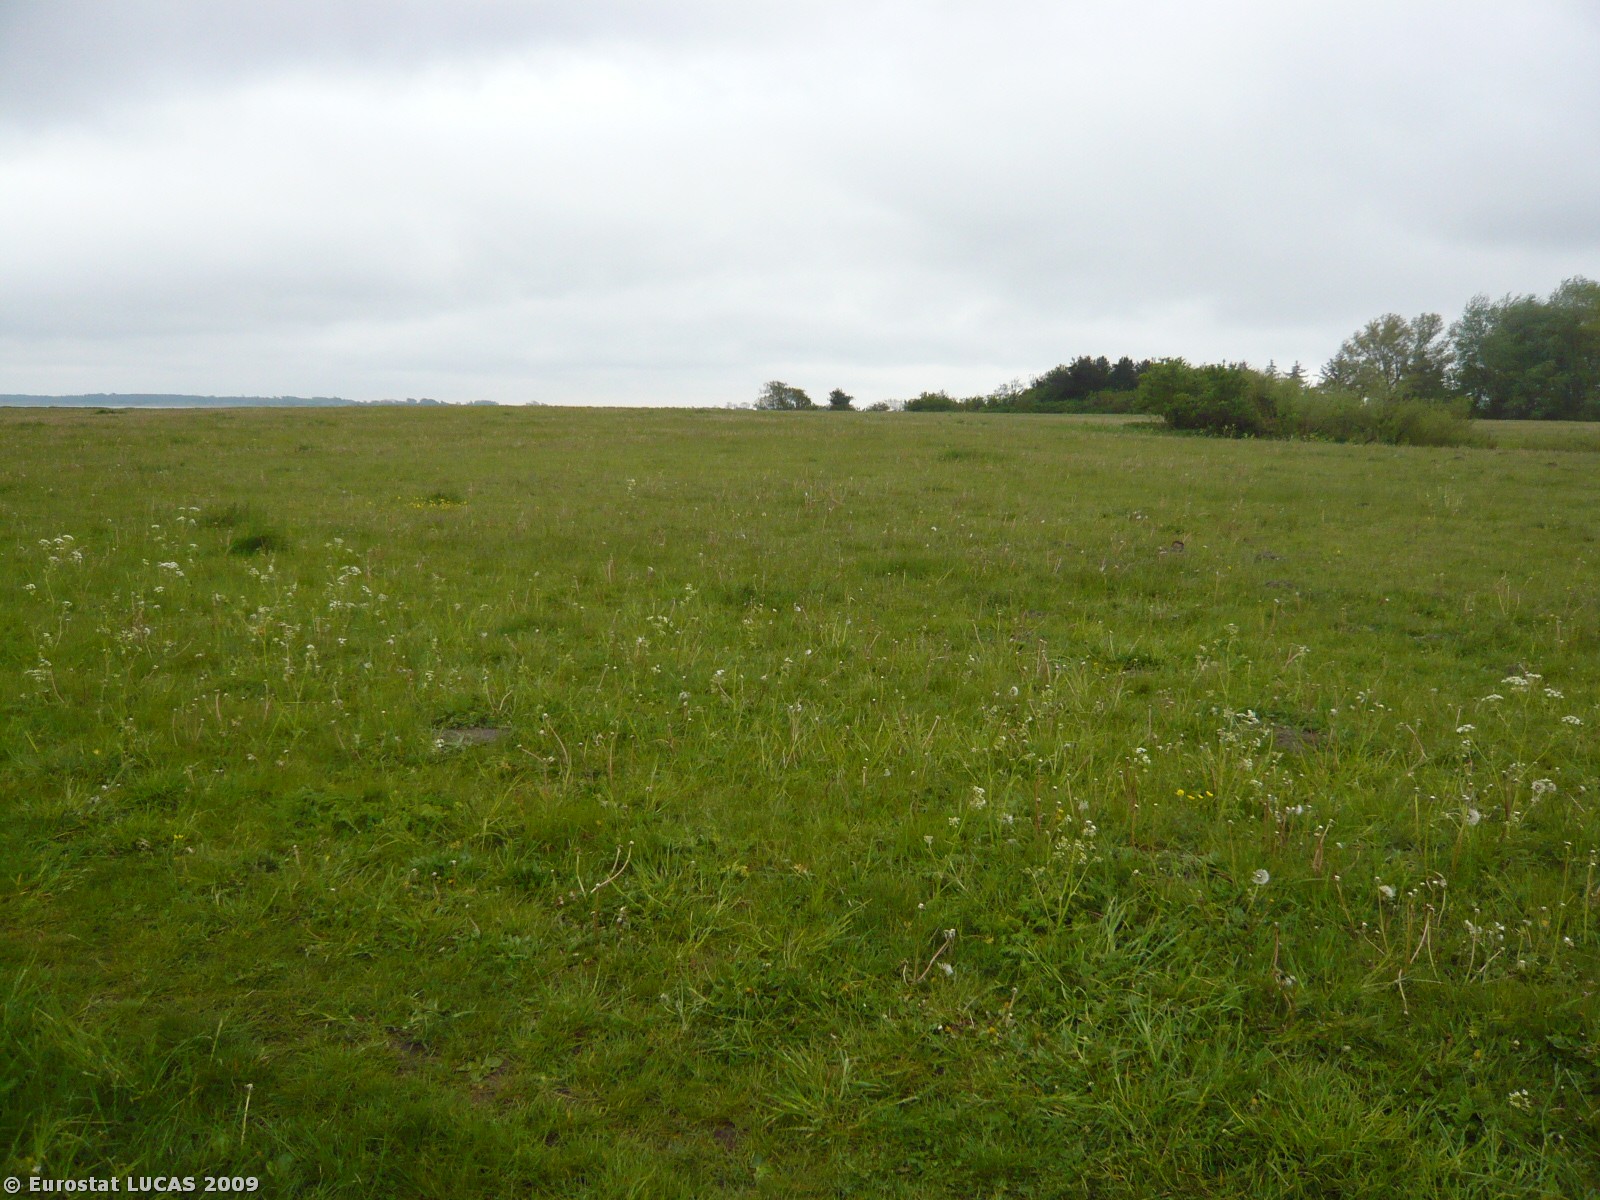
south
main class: Grassland
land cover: Grassland without tree/shrub cover
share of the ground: > 75 %
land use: Agriculture (excluding fallow land and kitchen gardens)
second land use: Nature reserves
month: May
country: DK
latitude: 55.0789
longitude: 11.7687
